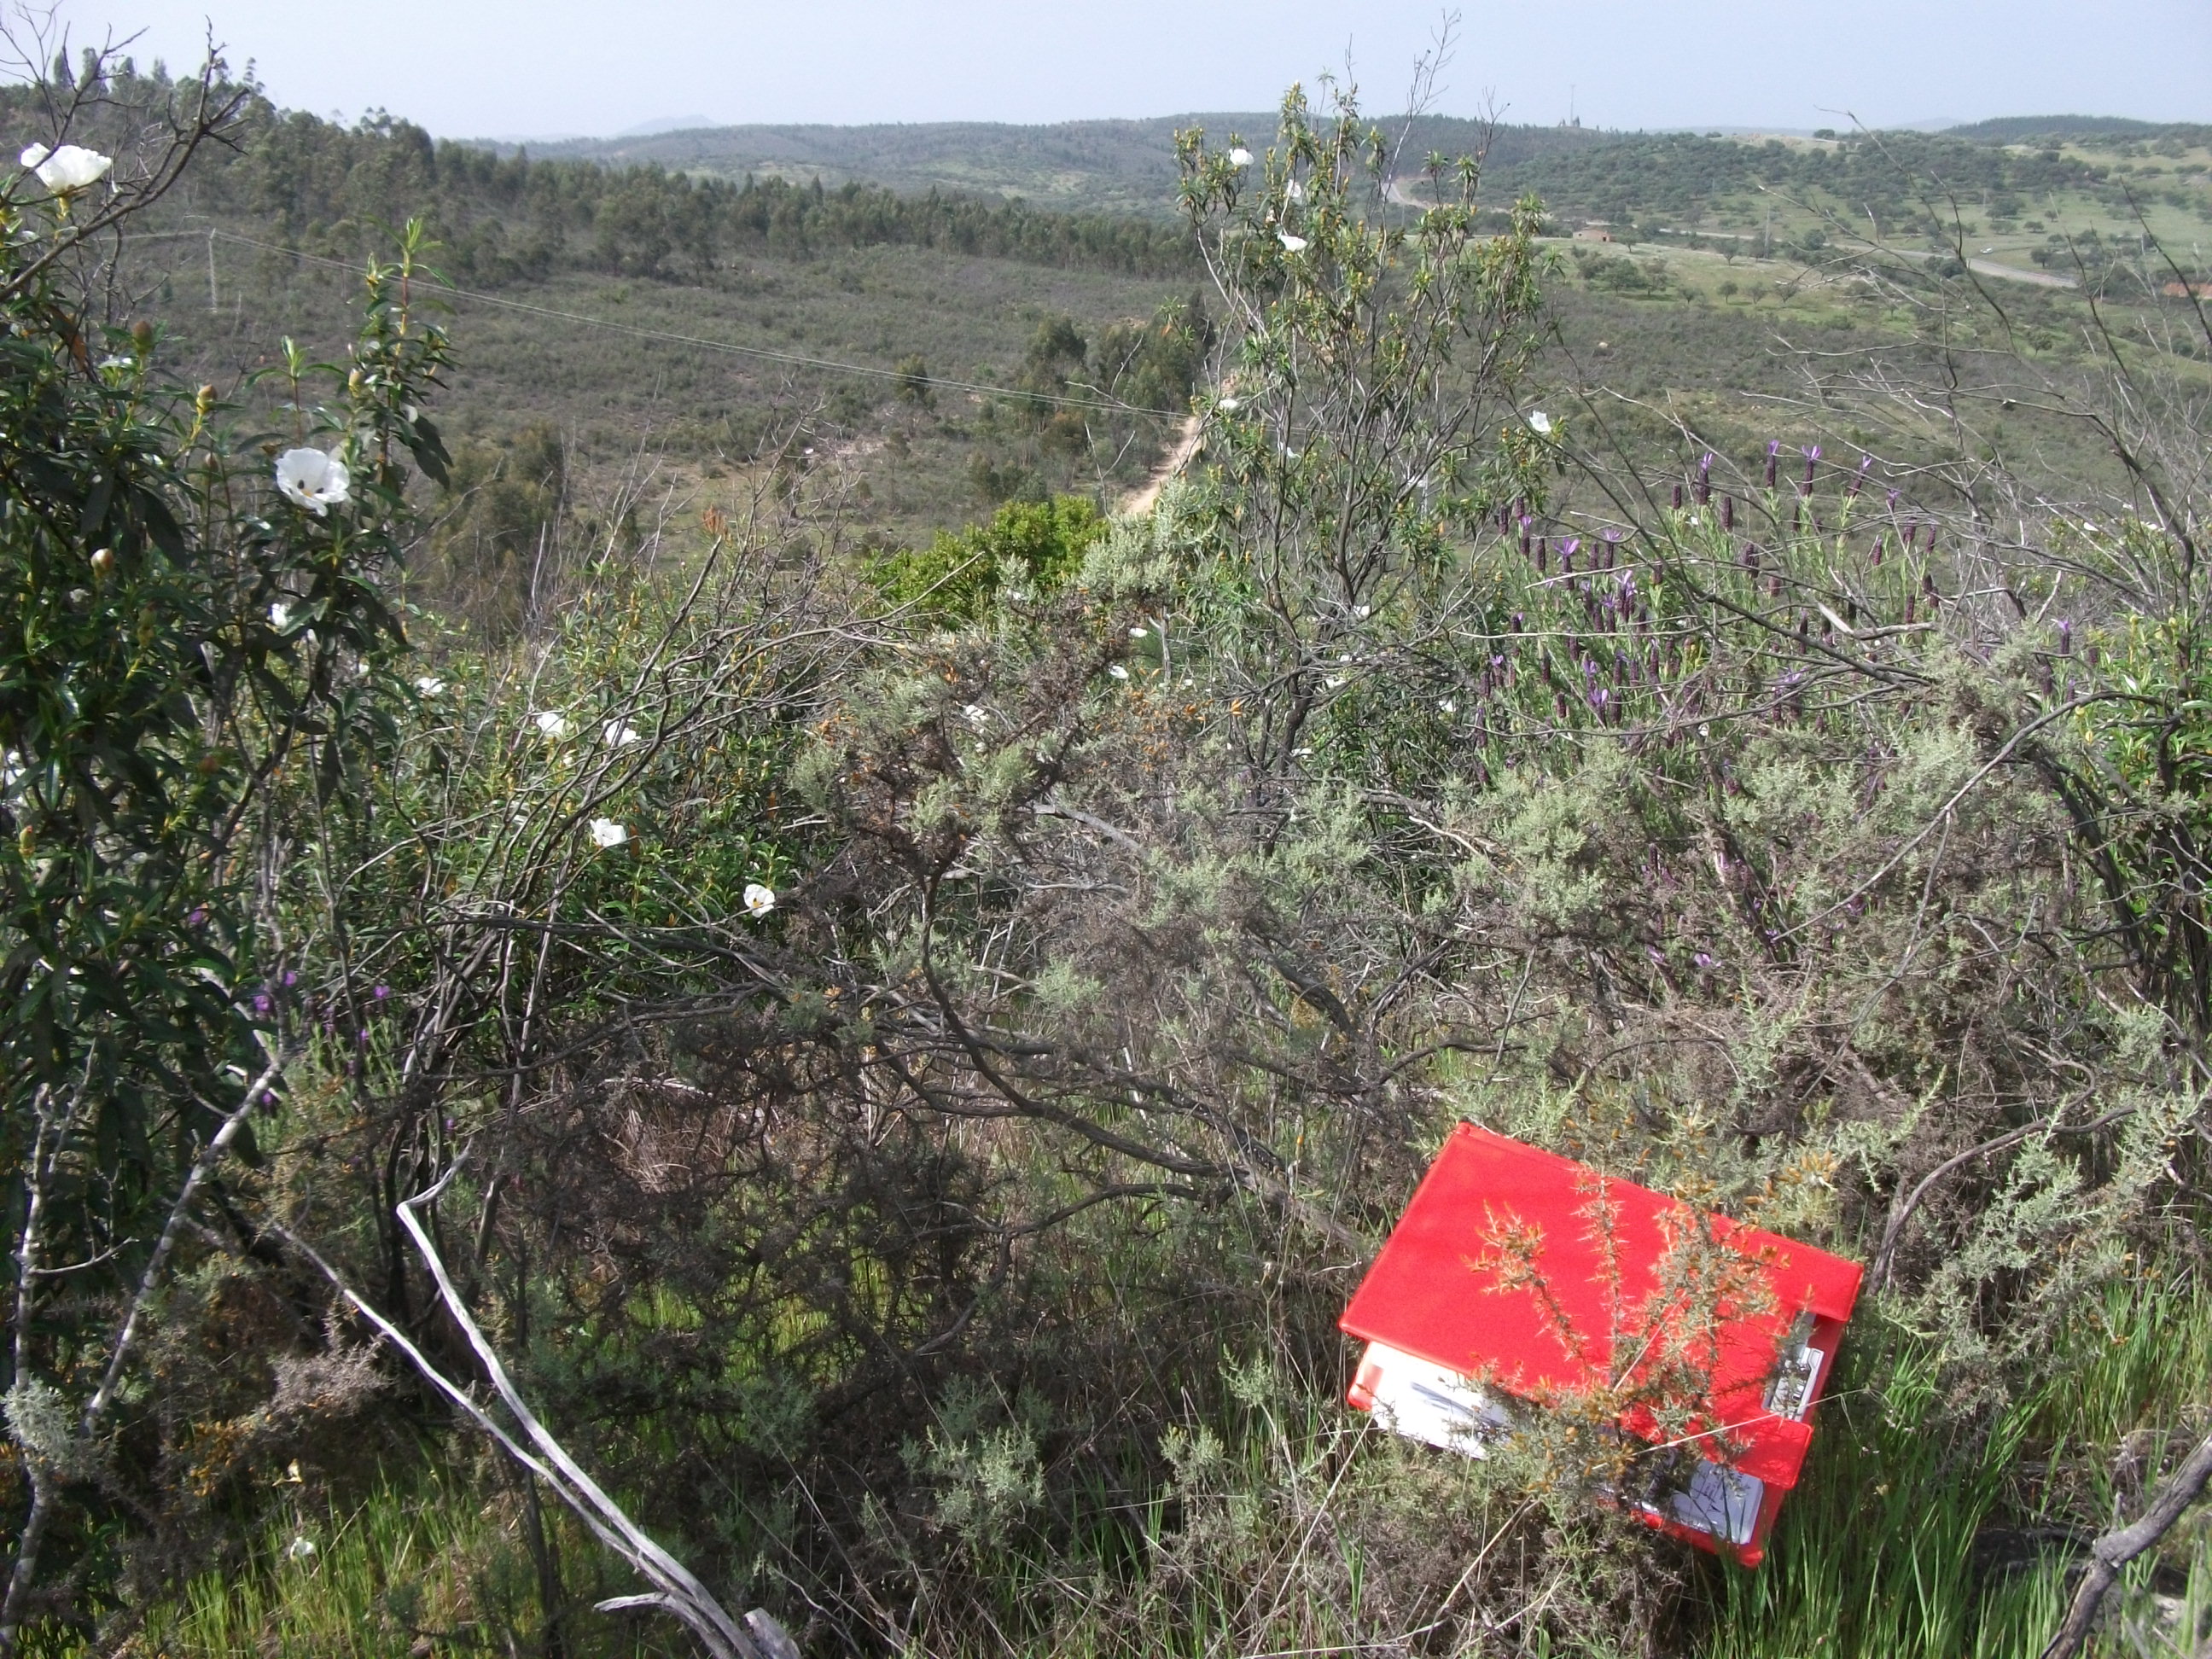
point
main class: Shrubland
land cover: Shrubland without tree cover
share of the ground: > 75 %
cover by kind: shrubs 90 %, herbaceous plants 10 %
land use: Semi-natural and natural areas not in use
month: April
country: ES
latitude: 37.7696
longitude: -6.7208
